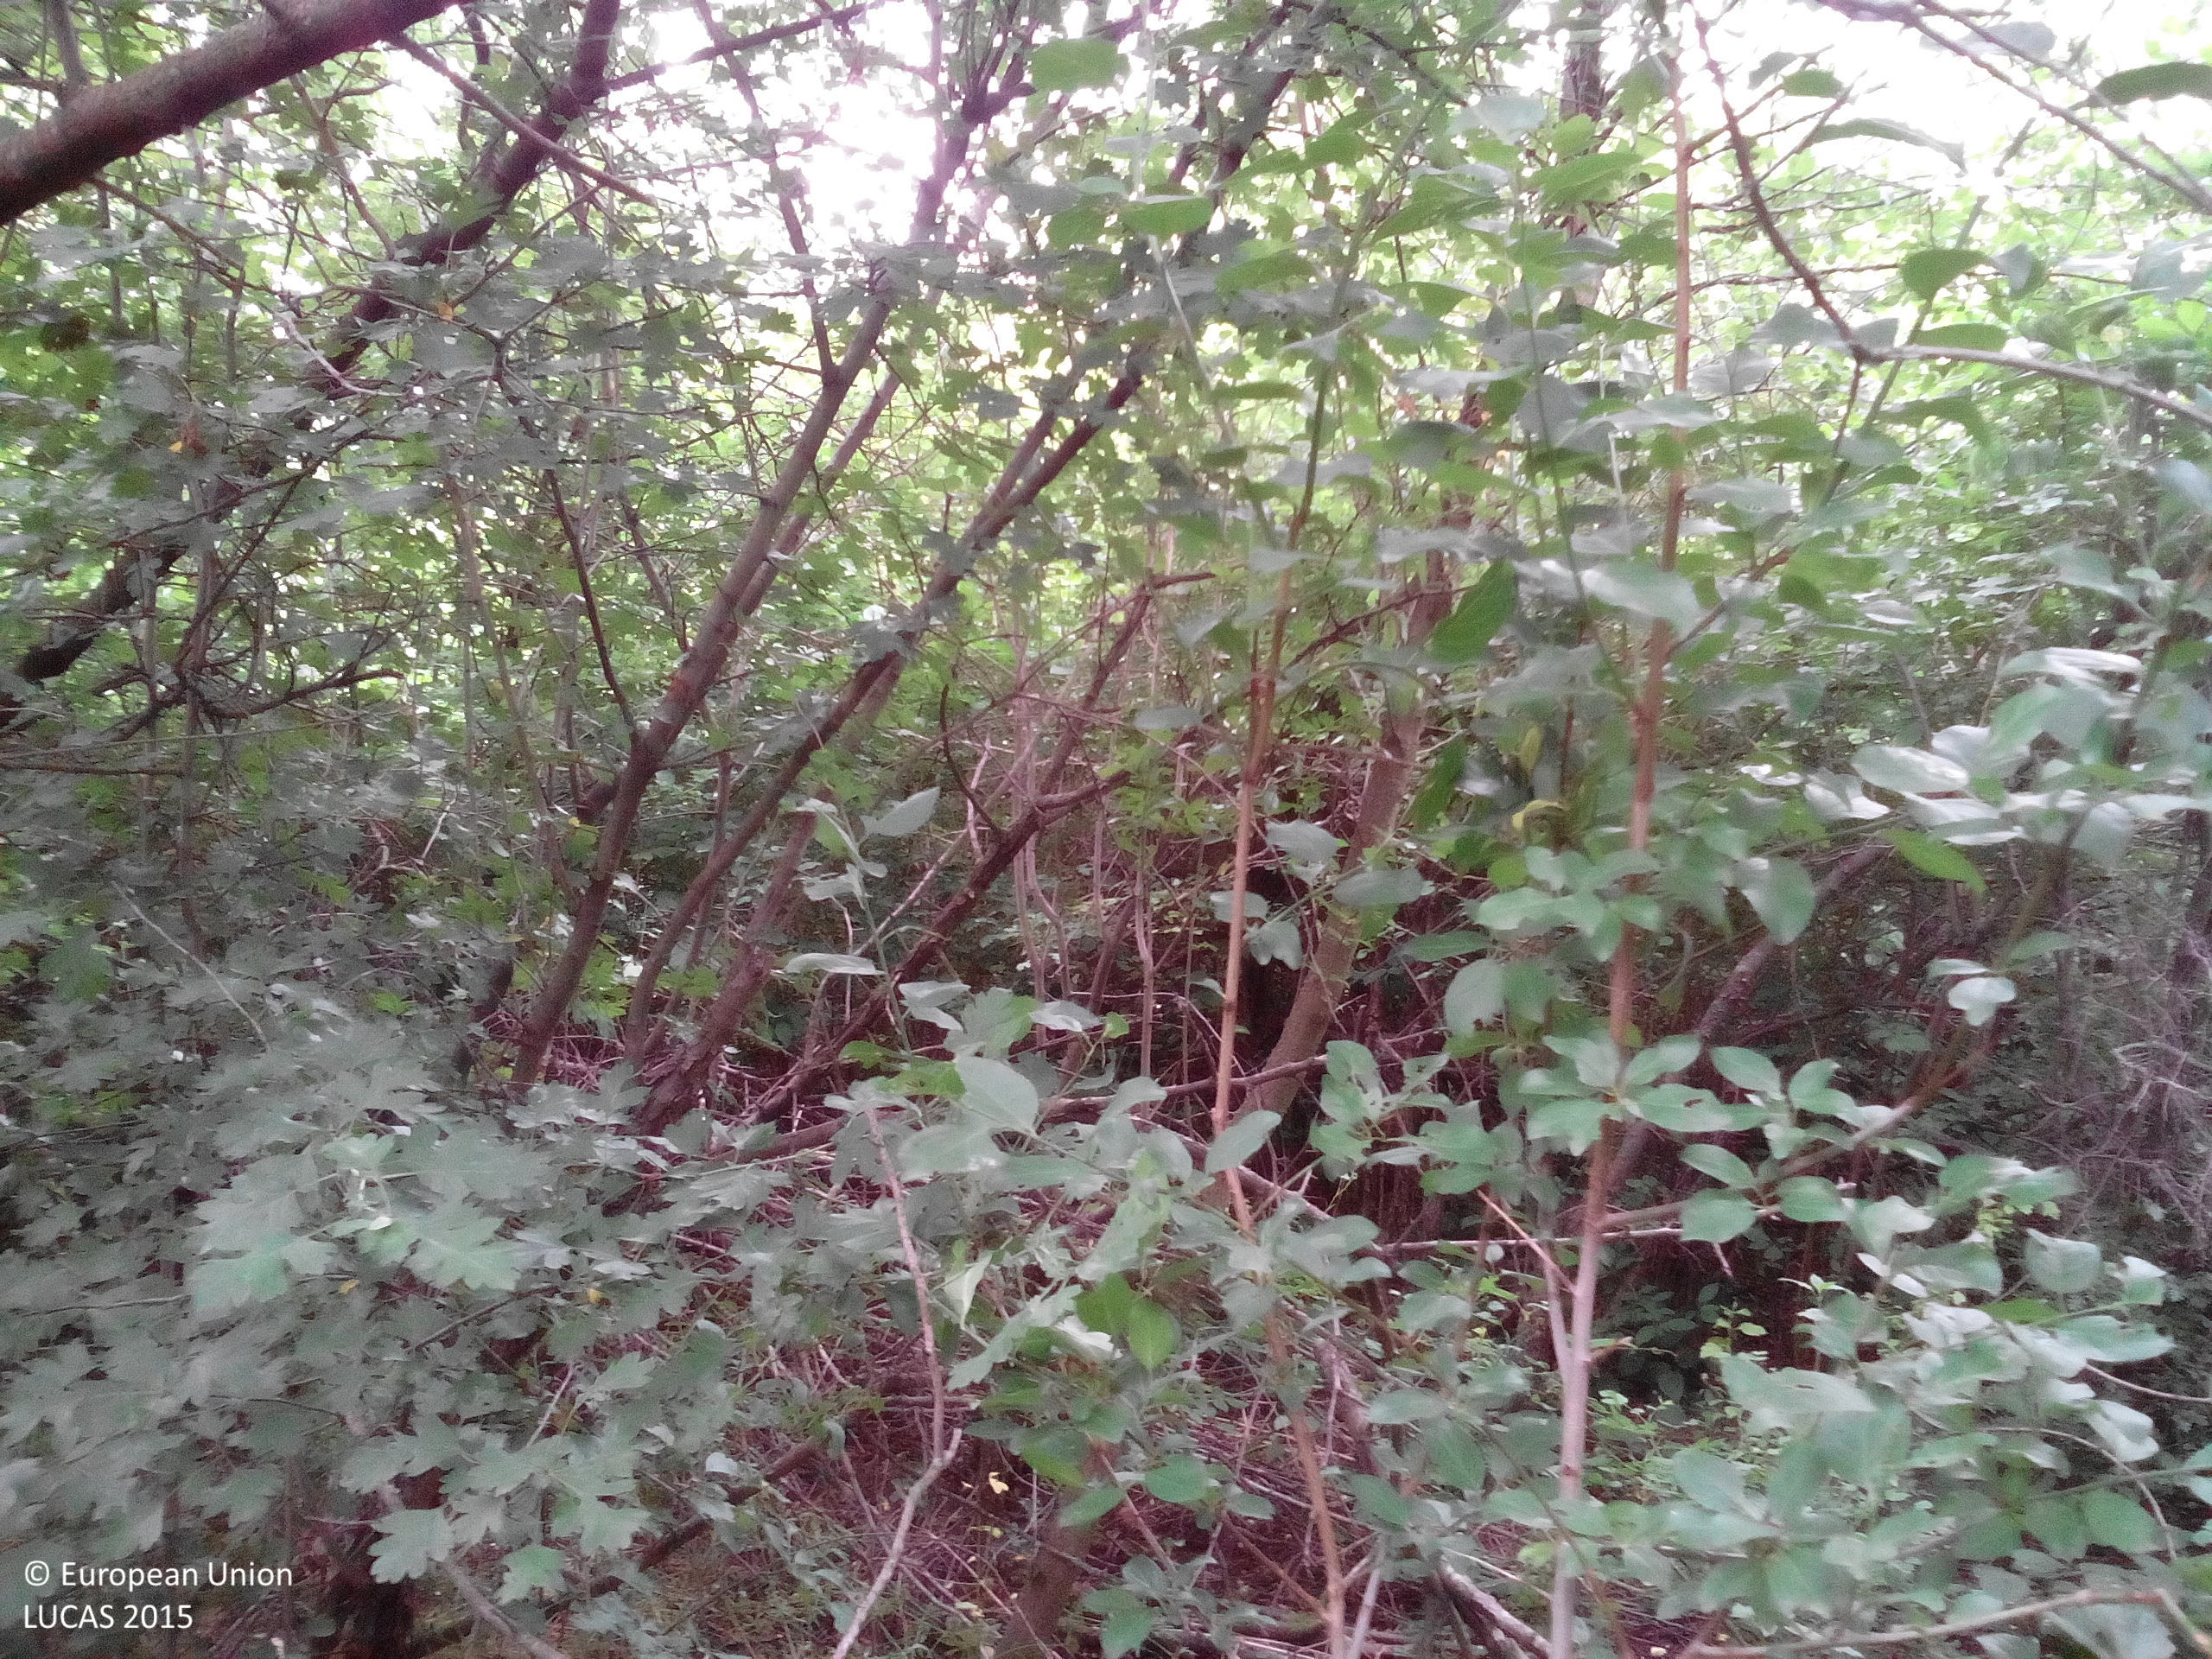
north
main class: Woodland
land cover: Broadleaved woodland
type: mesophytic deciduous forest
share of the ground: > 75 %
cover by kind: broadleaved forest trees 80 %, shrubs 15 %, herbaceous plants 5 %
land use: Semi-natural and natural areas not in use
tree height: > 5 m
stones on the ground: < 10 %
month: May
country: BG
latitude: 43.5471
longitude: 24.2290
